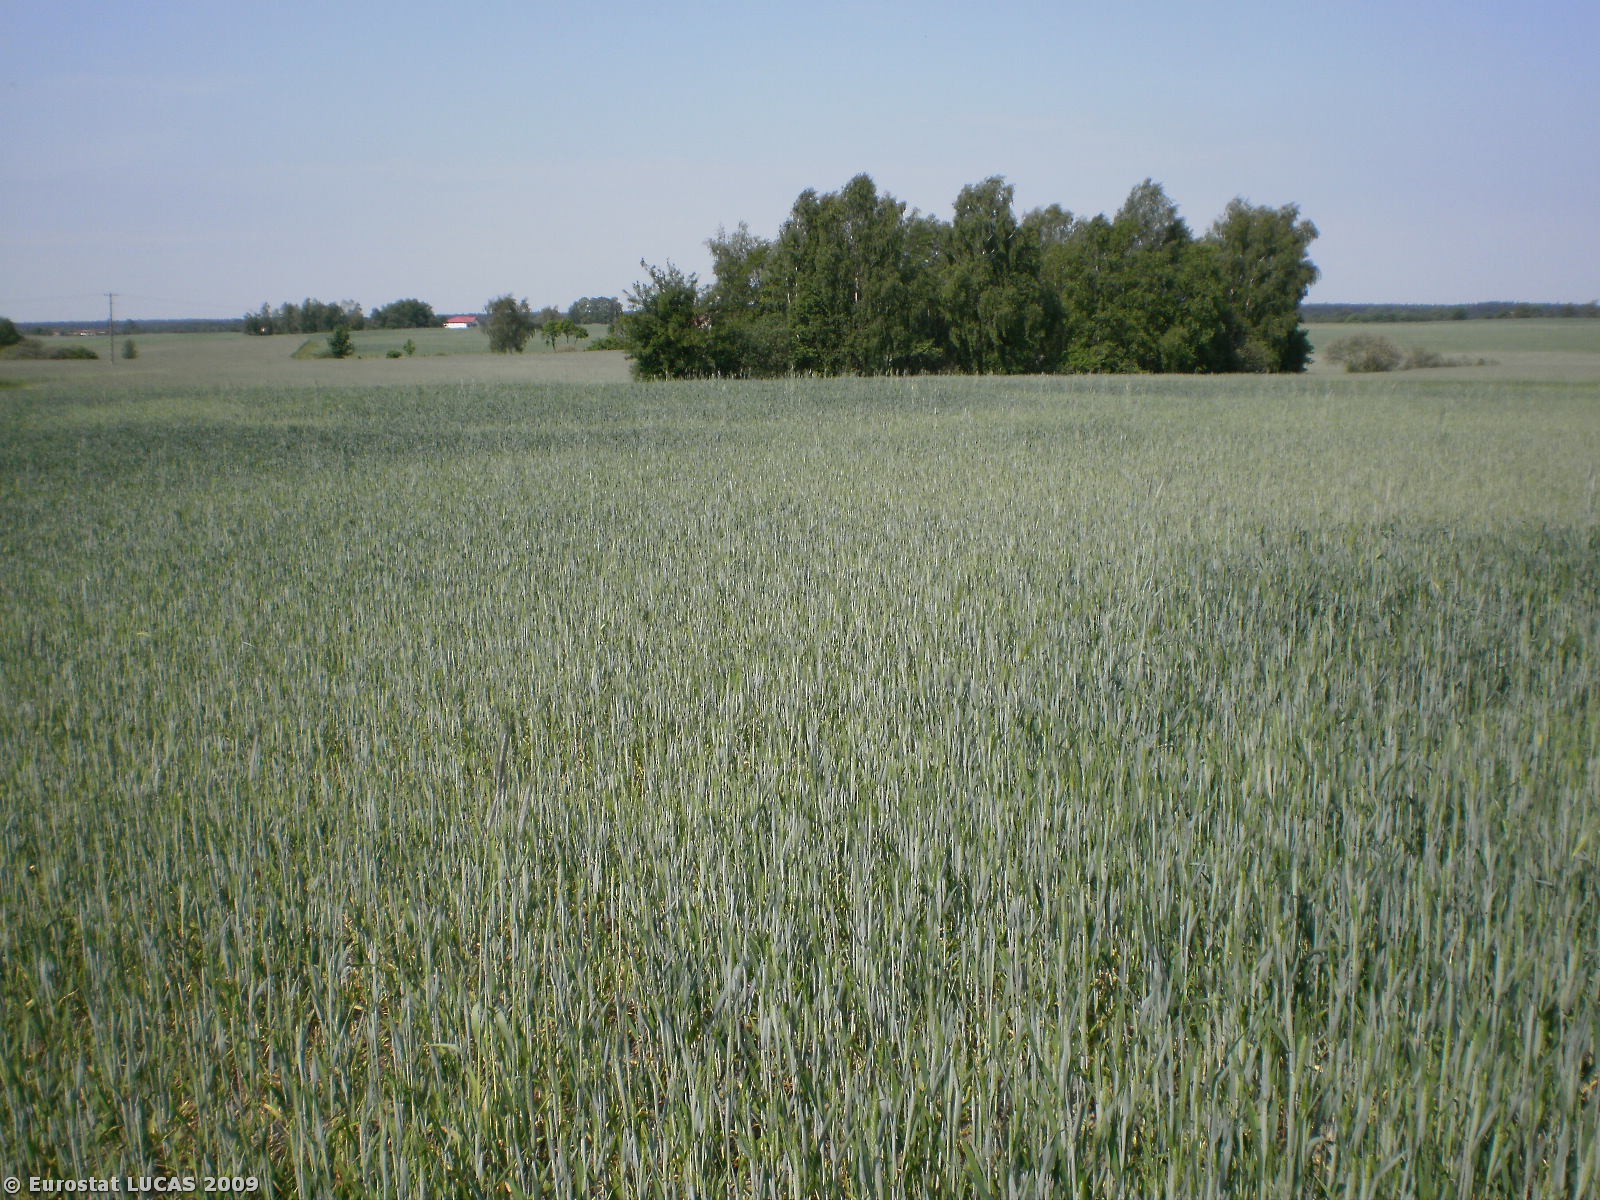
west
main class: Cropland
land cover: Triticale
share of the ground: > 75 %
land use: Agriculture (excluding fallow land and kitchen gardens)
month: May
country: PL
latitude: 53.4019
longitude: 18.0923
